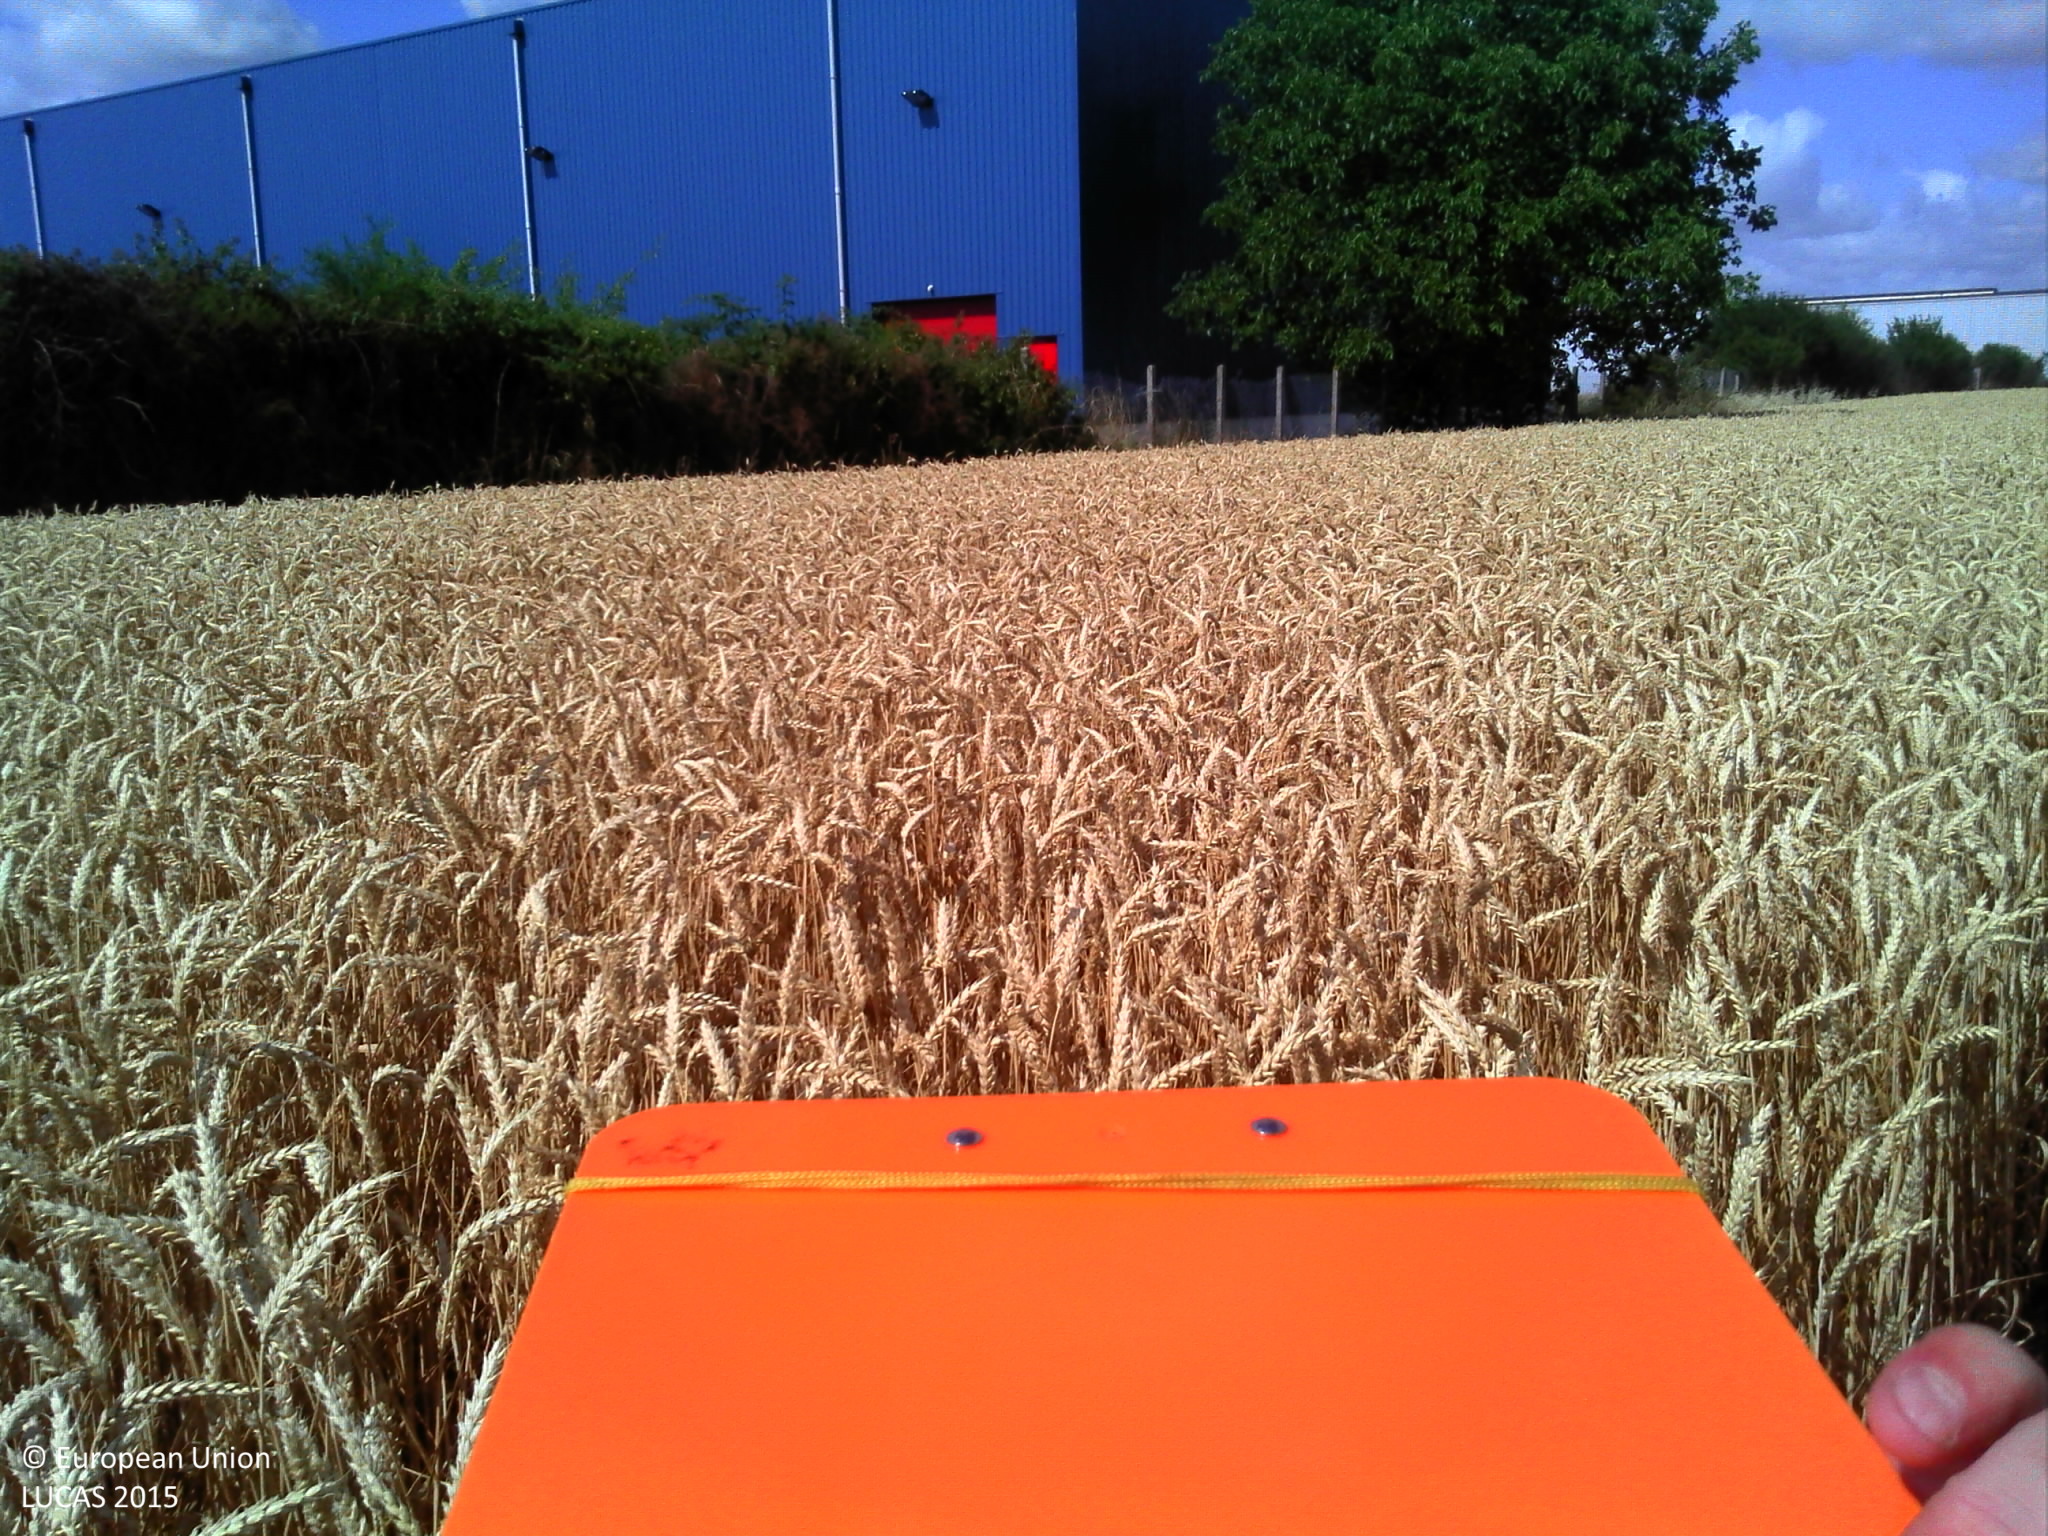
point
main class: Cropland
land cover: Common wheat
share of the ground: > 75 %
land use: Agriculture (excluding fallow land and kitchen gardens)
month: July
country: FR
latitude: 48.0969
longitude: 2.8080
